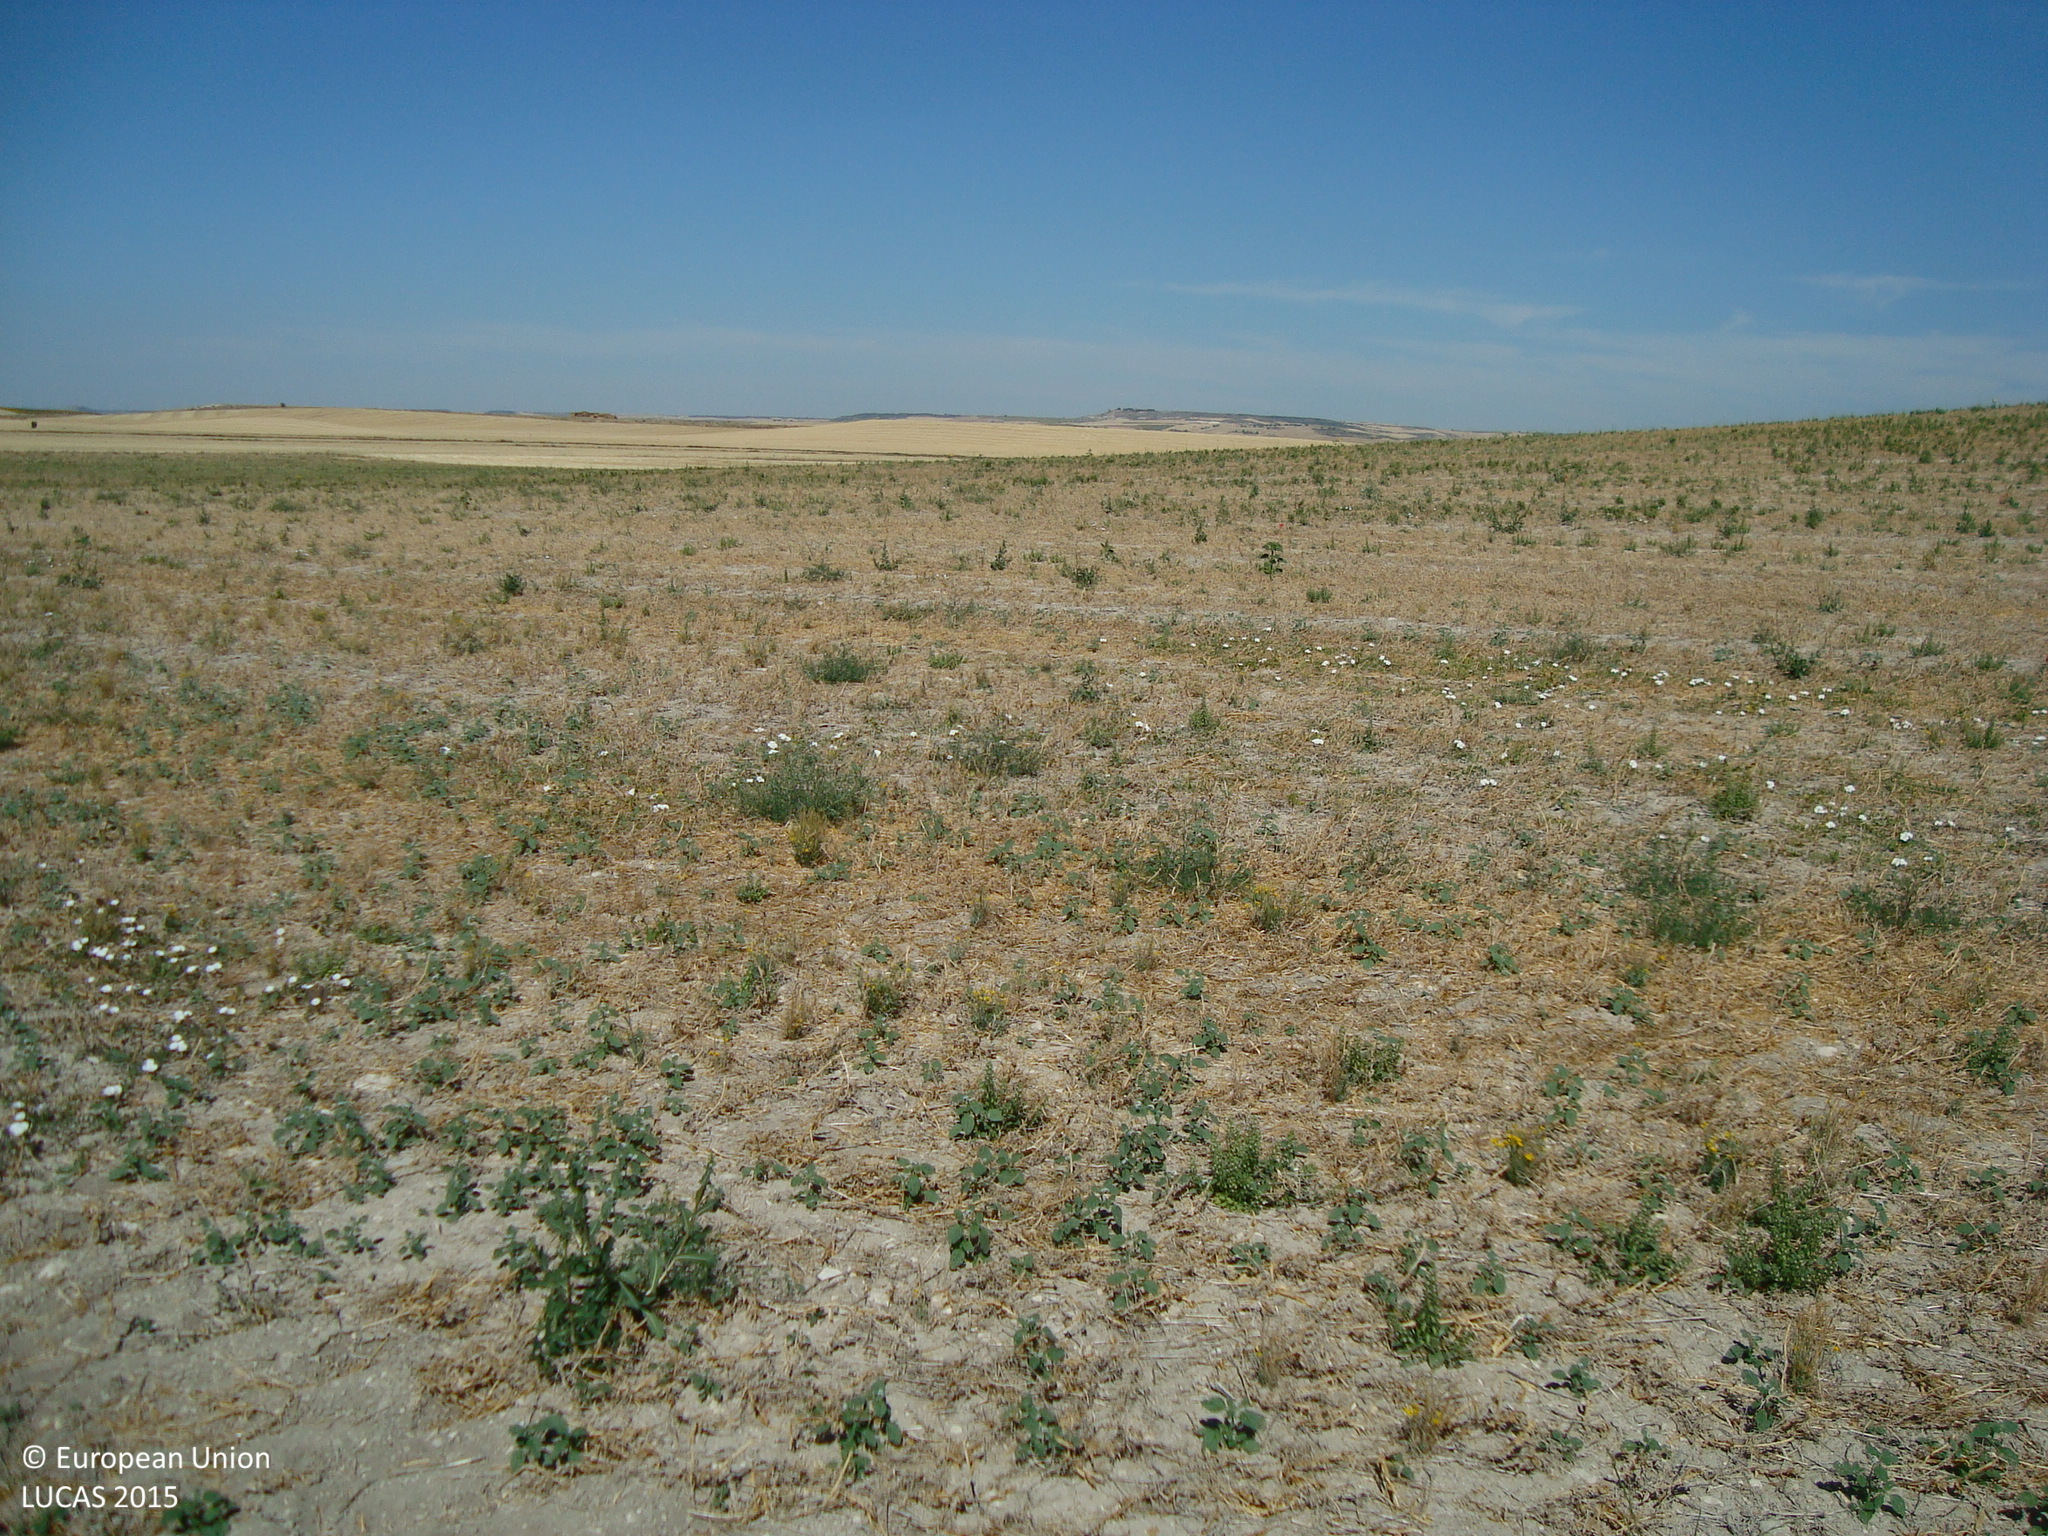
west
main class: Cropland
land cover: Dry pulses
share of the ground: 50 - 75 %
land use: Agriculture (excluding fallow land and kitchen gardens)
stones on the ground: 10 - 25 %
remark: Harvested field
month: July
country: ES
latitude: 42.0242
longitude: -4.2566
